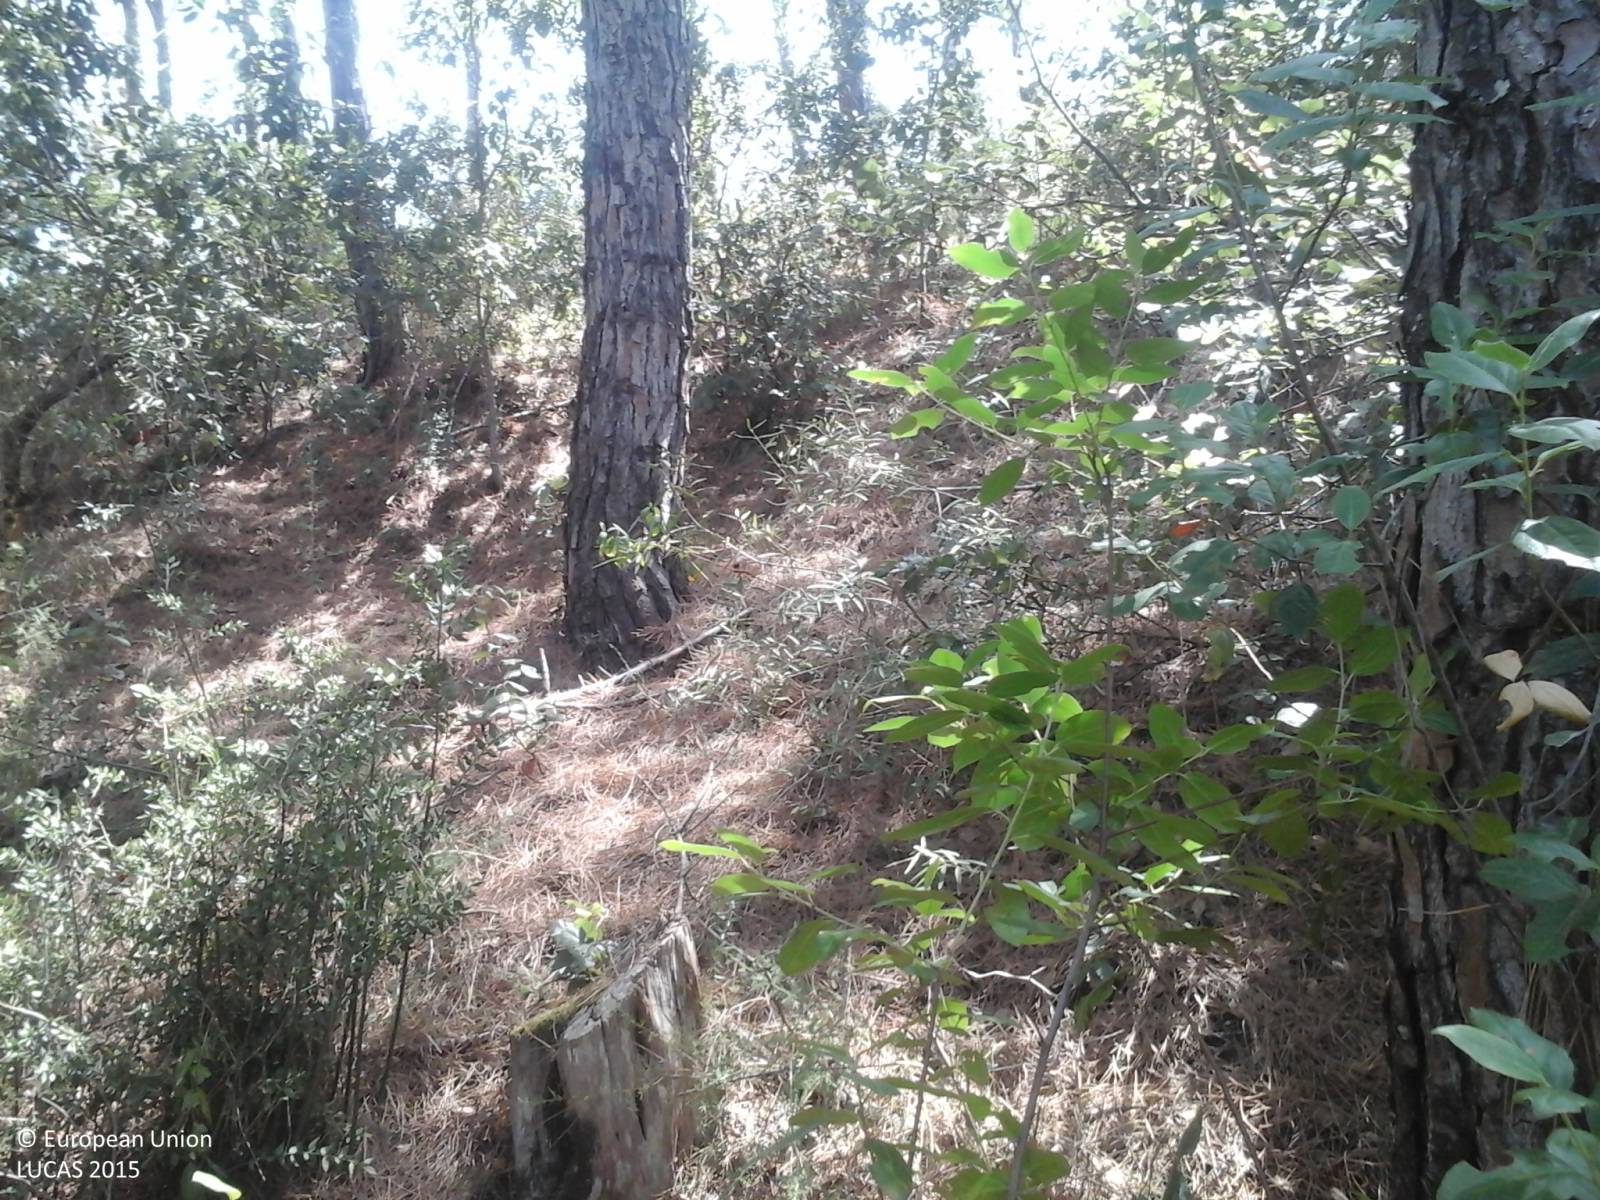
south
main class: Woodland
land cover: Pine dominated coniferous woodland
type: coniferous forest of the mediterranean region
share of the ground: 10 - 25 %
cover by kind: herbaceous plants 60 %, shrubs 30 %, coniferous forest trees 10 %
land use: Semi-natural and natural areas not in use
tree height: > 5 m
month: July
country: IT
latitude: 41.1686
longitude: 9.1813
